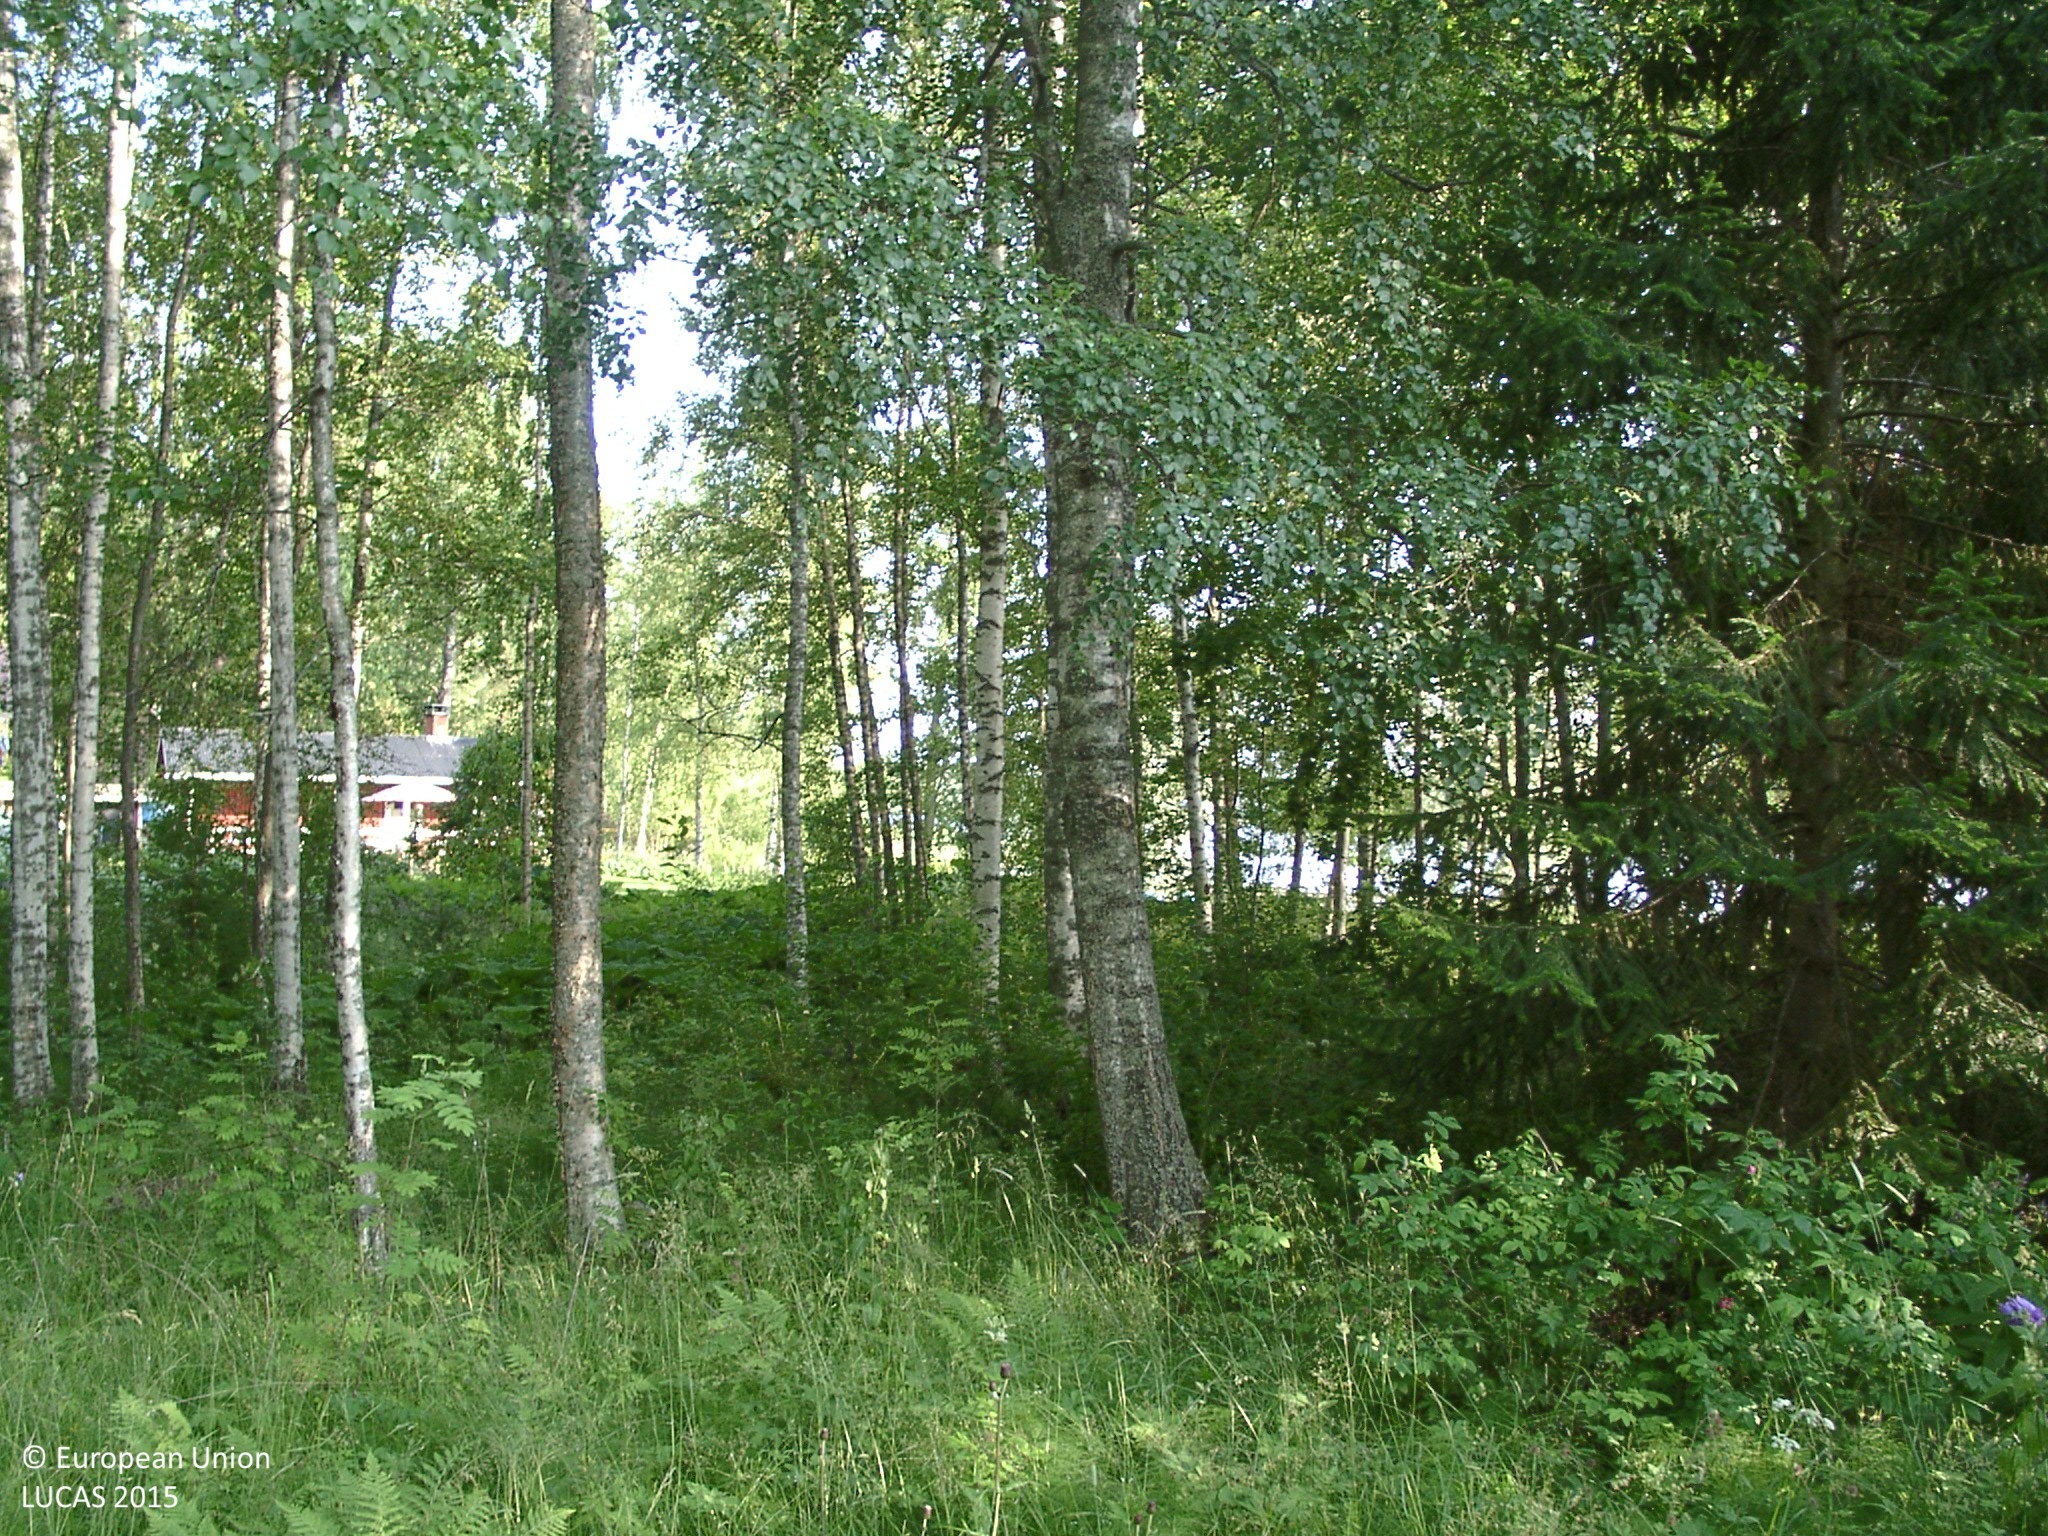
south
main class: Woodland
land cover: Broadleaved woodland
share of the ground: > 75 %
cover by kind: broadleaved forest trees 70 %, herbaceous plants 25 %, coniferous forest trees 5 %
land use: Residential
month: July
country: FI
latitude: 61.5587
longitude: 25.1898
